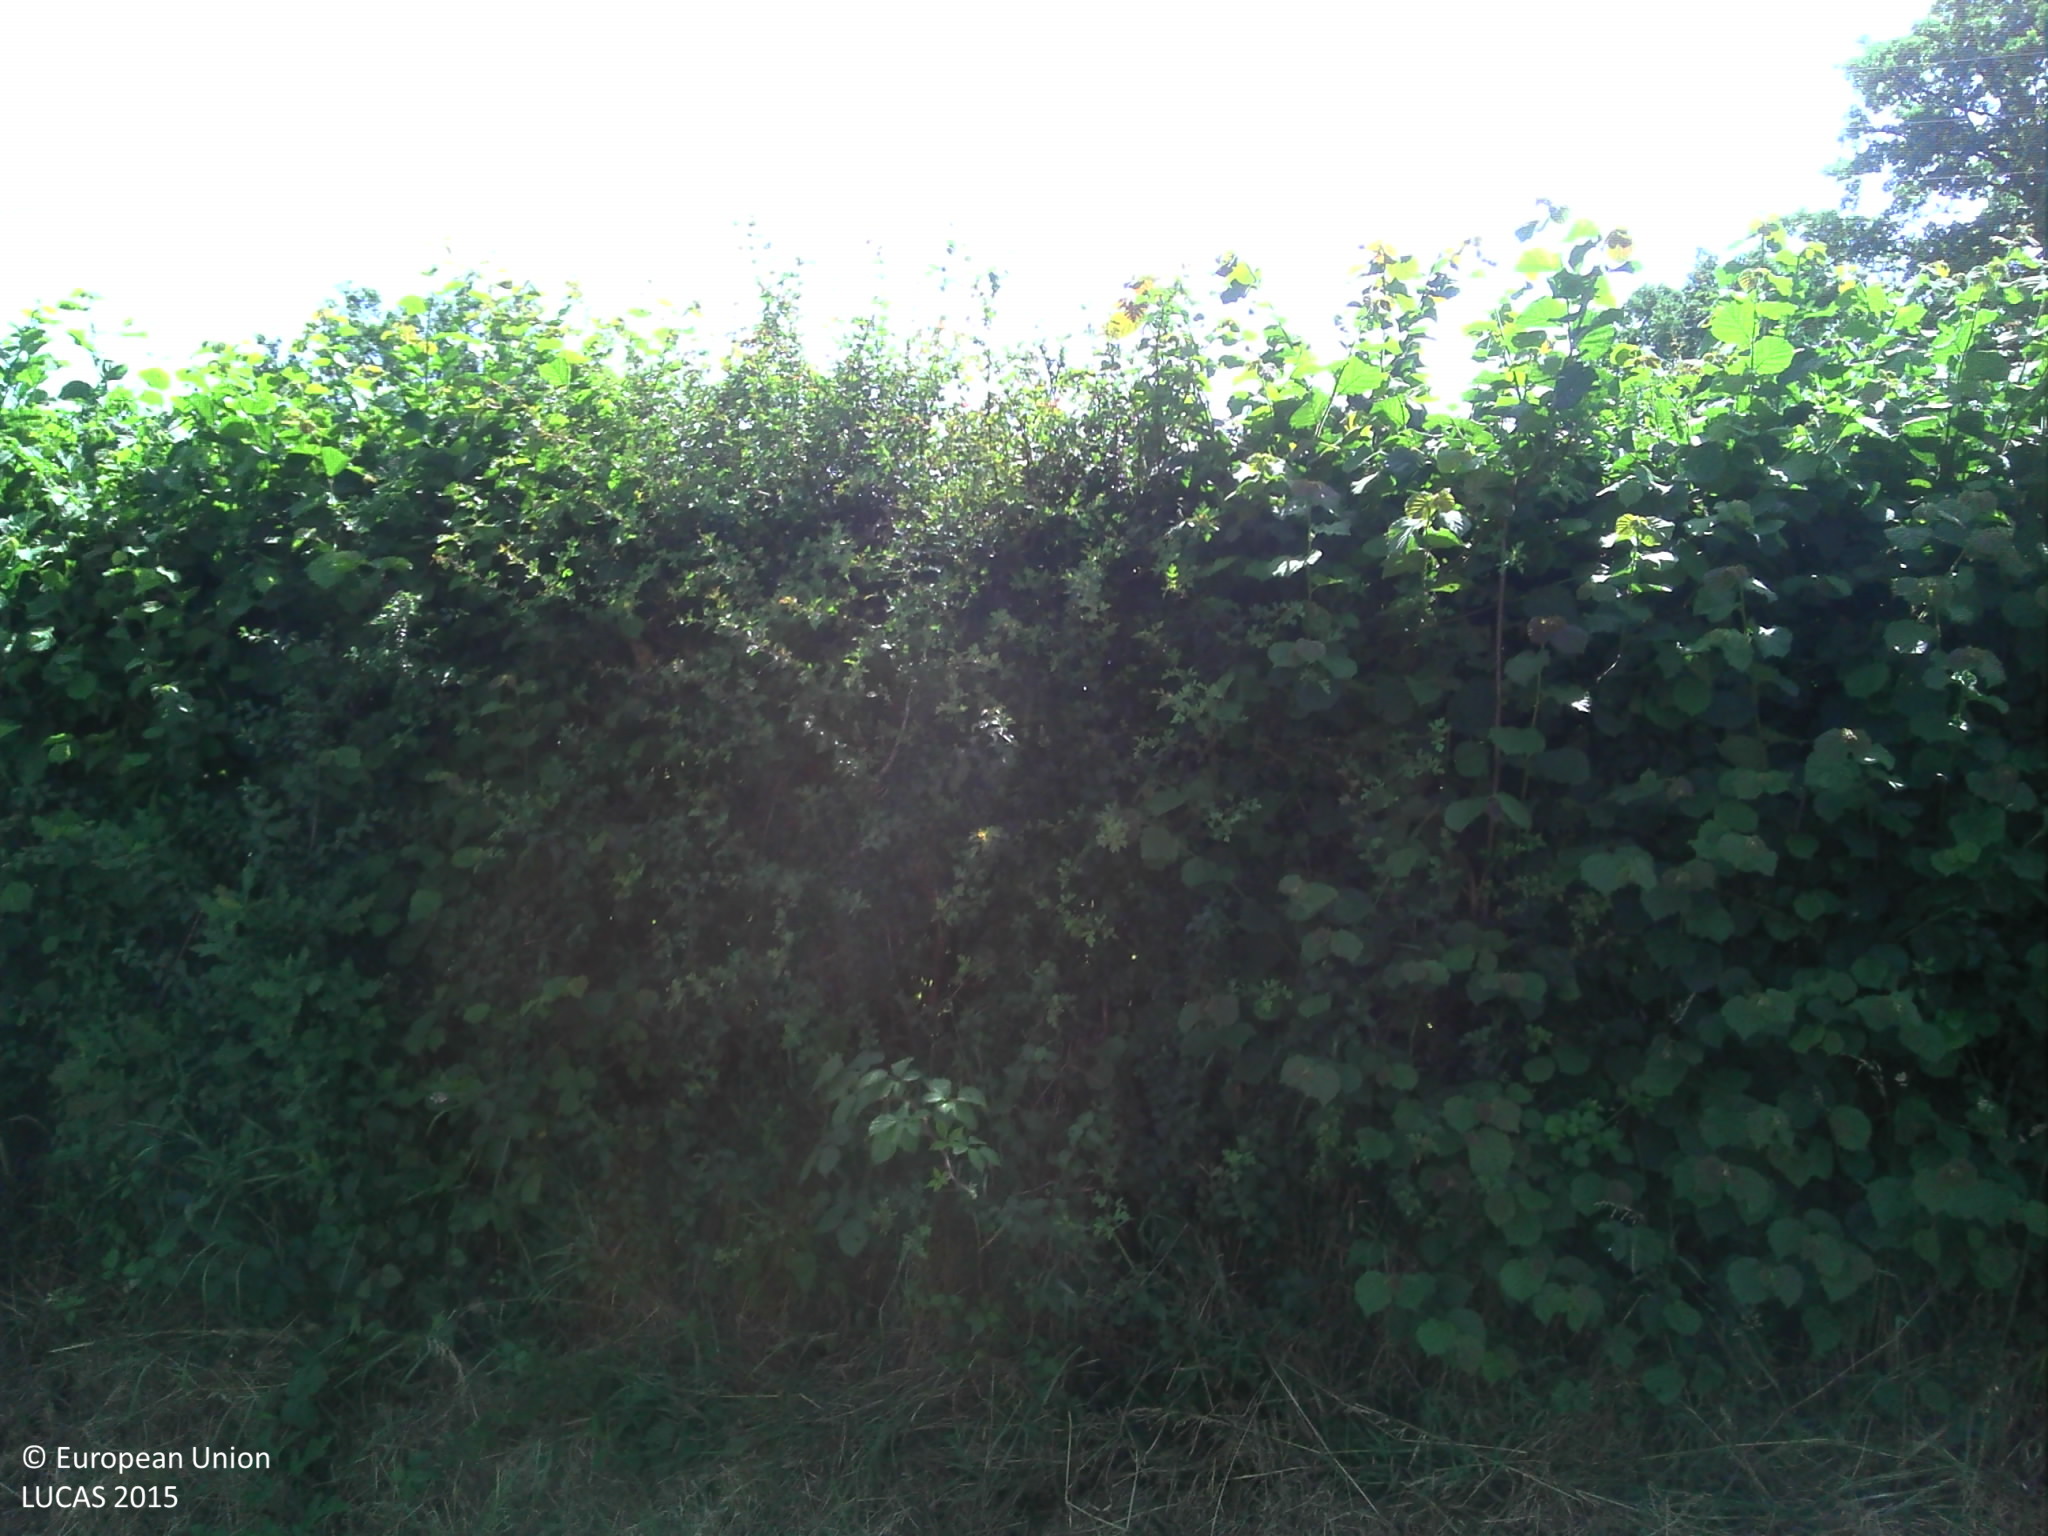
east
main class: Cropland
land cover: Rape and turnip rape
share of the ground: > 75 %
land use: Agriculture (excluding fallow land and kitchen gardens)
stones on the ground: 10 - 25 %
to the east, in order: Rape and turnip rape; Managed hedges; Tracks; Grass margins; Managed hedges; Fences; Grassland without tree/shrub cover; Electric lines; Grassland without tree/shrub cover; Single bushes/trees; Grassland without tree/shrub cover
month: June
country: FR
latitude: 46.3294
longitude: 4.0385
